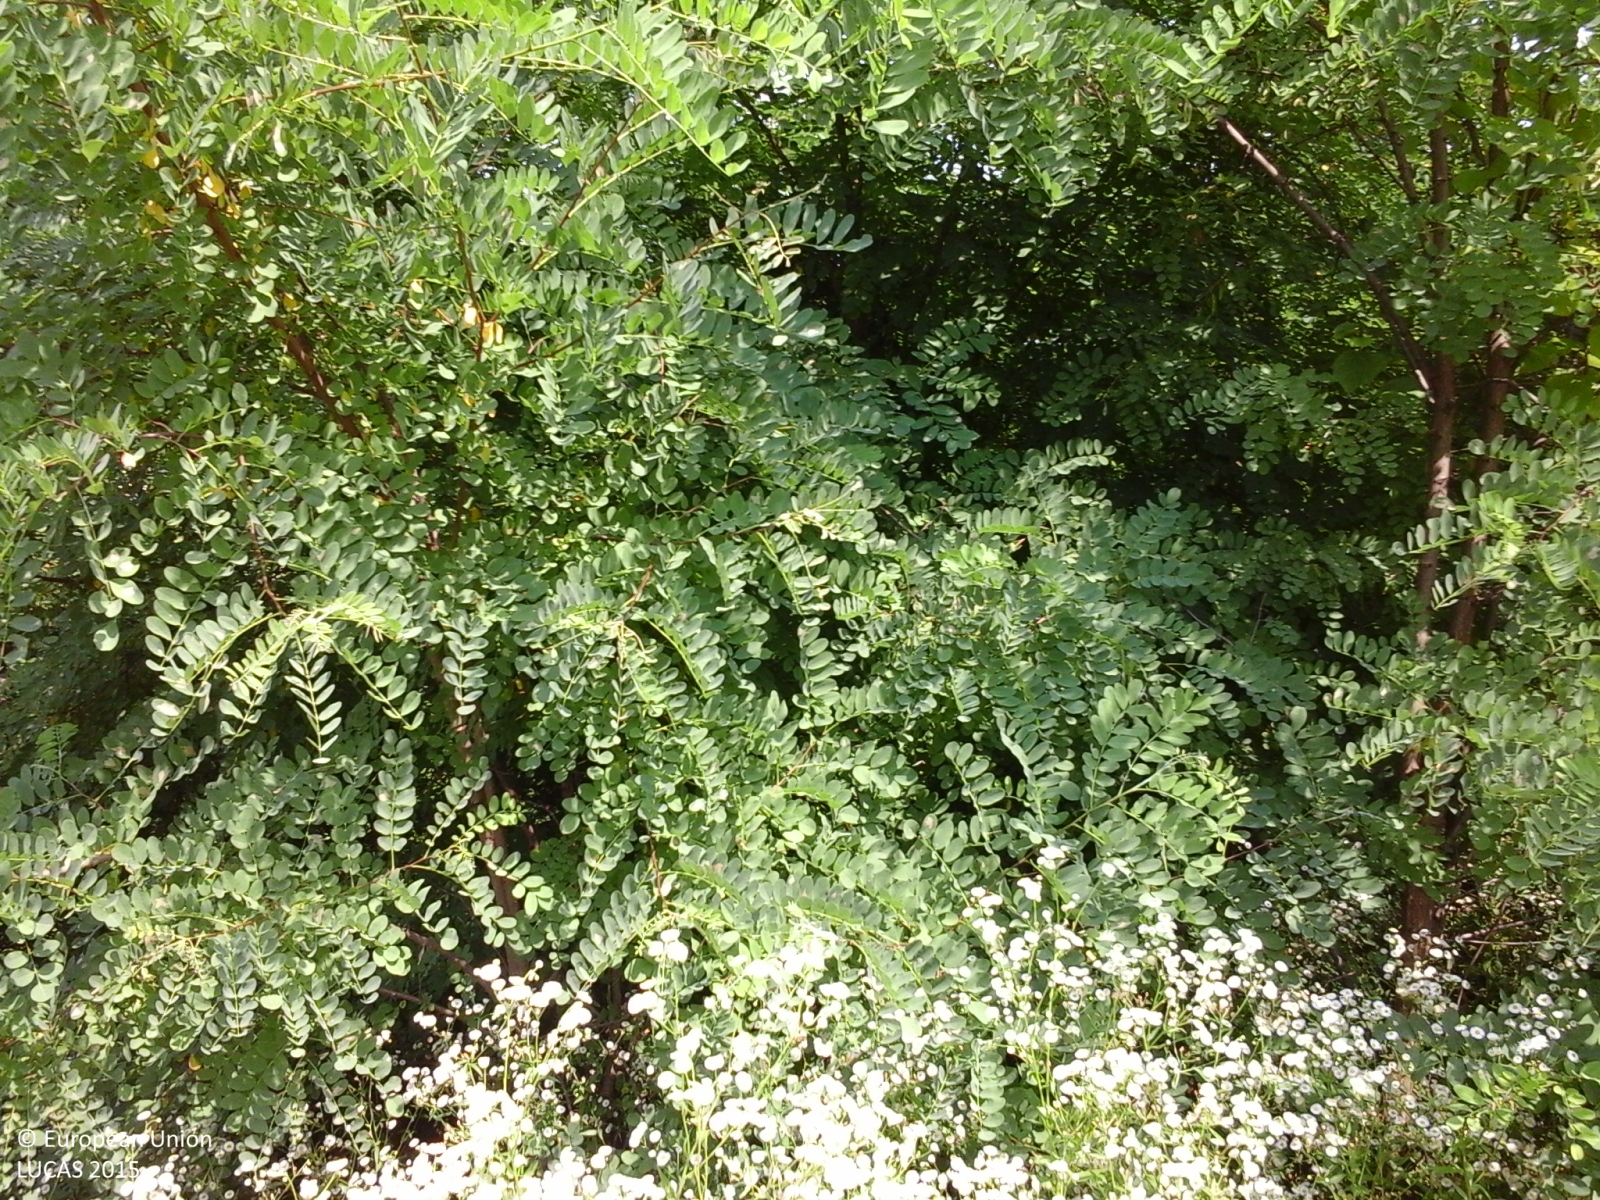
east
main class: Grassland
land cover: Grassland with sparse tree/shrub cover
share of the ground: > 75 %
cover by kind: herbaceous plants 90 %, broadleaved forest trees 5 %, shrubs 5 %
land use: Abandoned areas
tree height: > 5 m
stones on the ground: < 10 %
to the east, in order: Grassland with sparse tree/shrub cover; Fences; Broadleaved woodland; Inland fresh running water; Grass margins; Paved roads, cycling and walking lanes; Grassland without tree/shrub cover; Fences; Other fresh vegetables; Grassland without tree/shrub cover
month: June
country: IT
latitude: 44.6671
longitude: 8.7036
